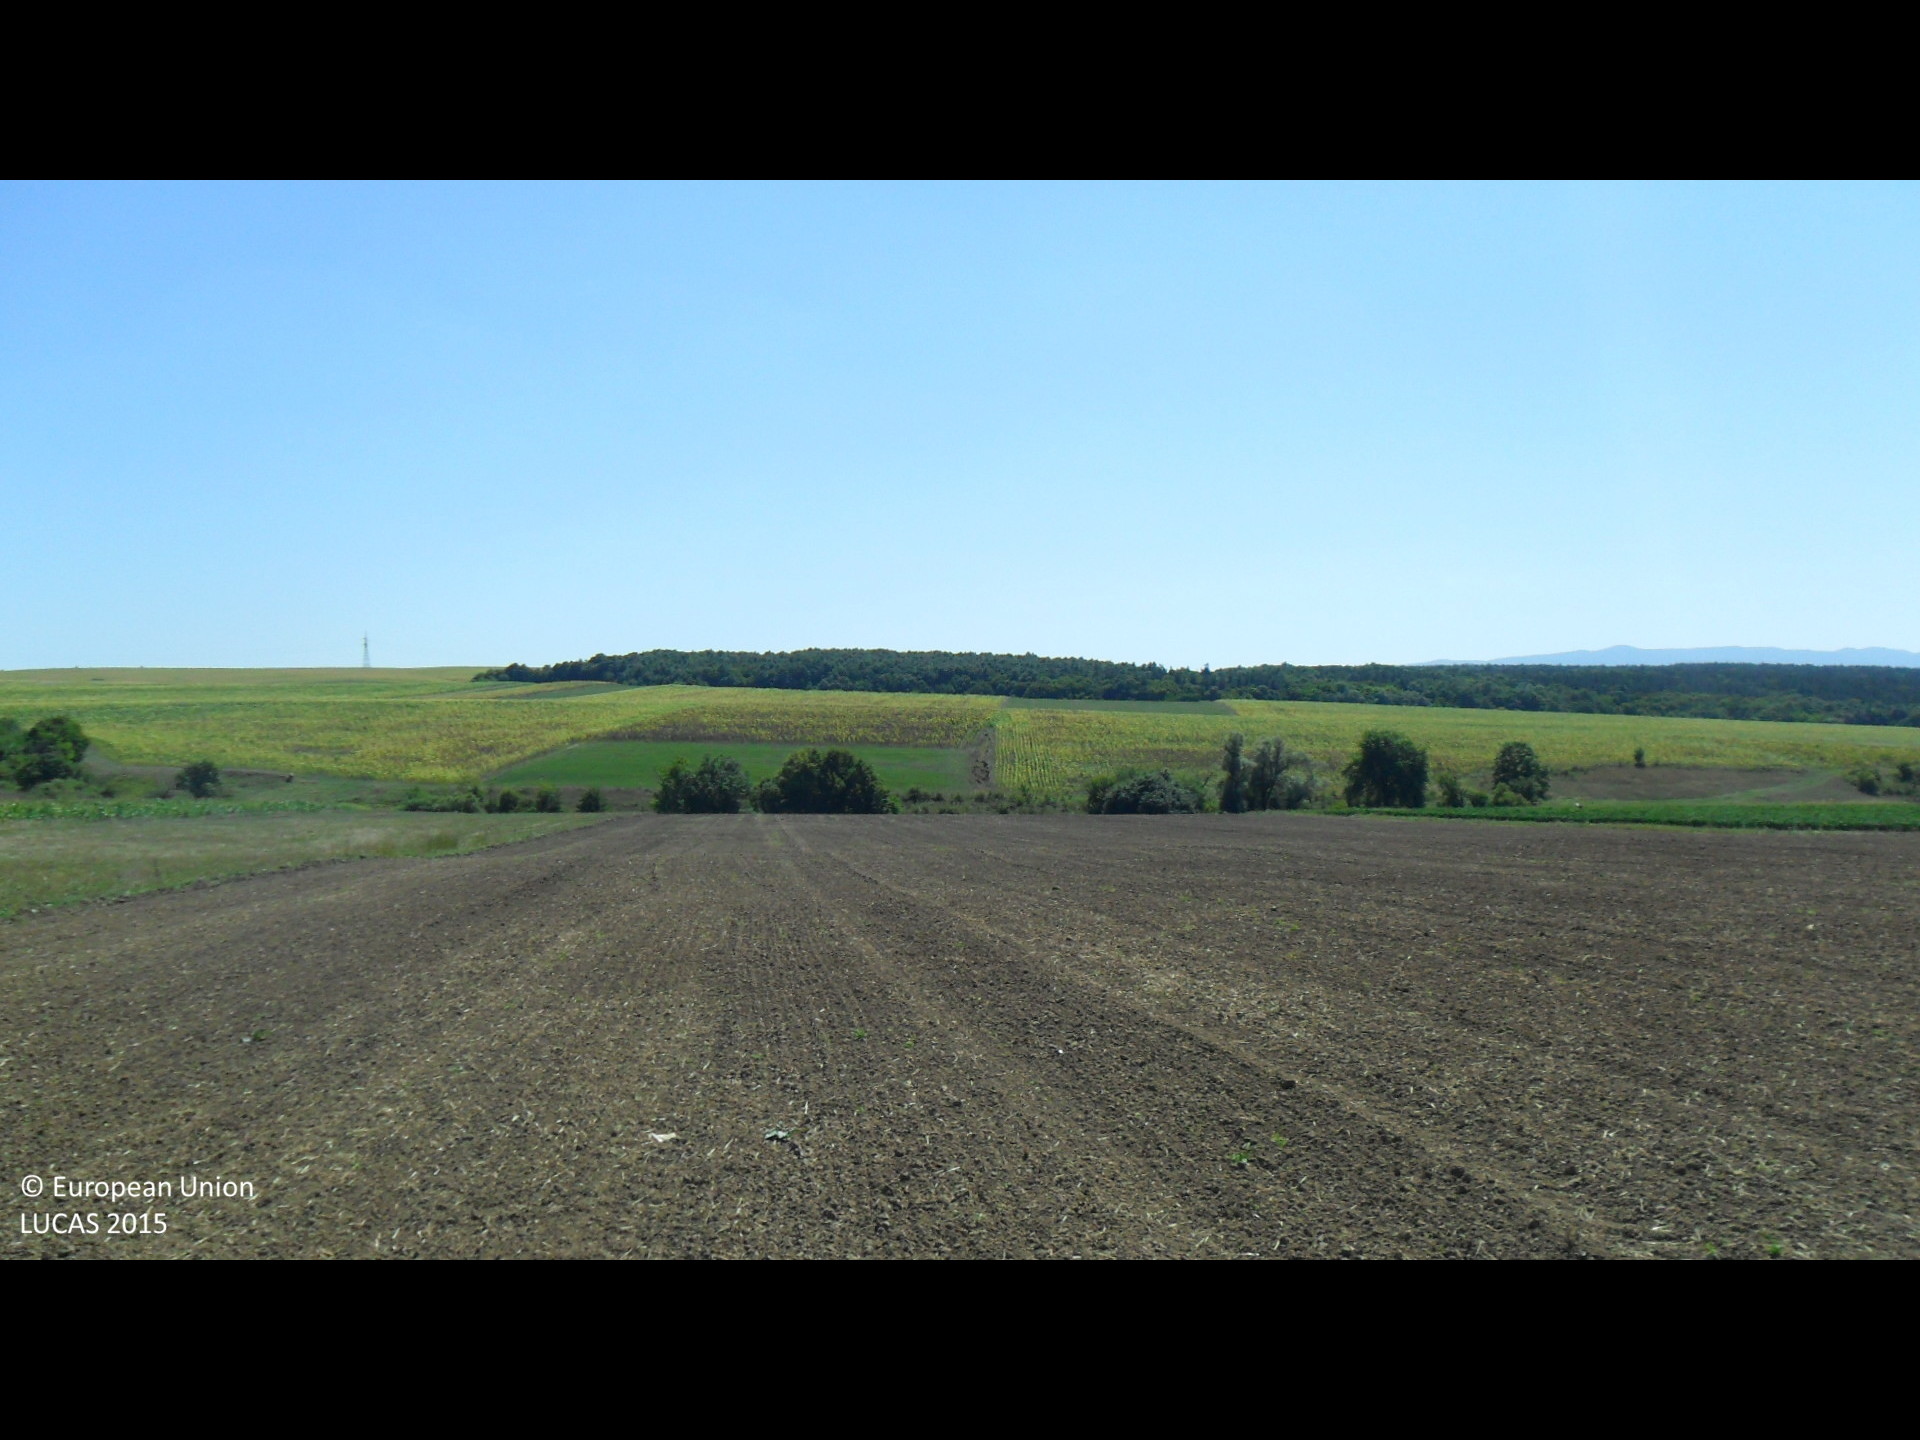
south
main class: Cropland
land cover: Common wheat
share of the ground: < 10 %
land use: Agriculture (excluding fallow land and kitchen gardens)
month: September
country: BG
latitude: 43.1741
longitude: 26.4482
